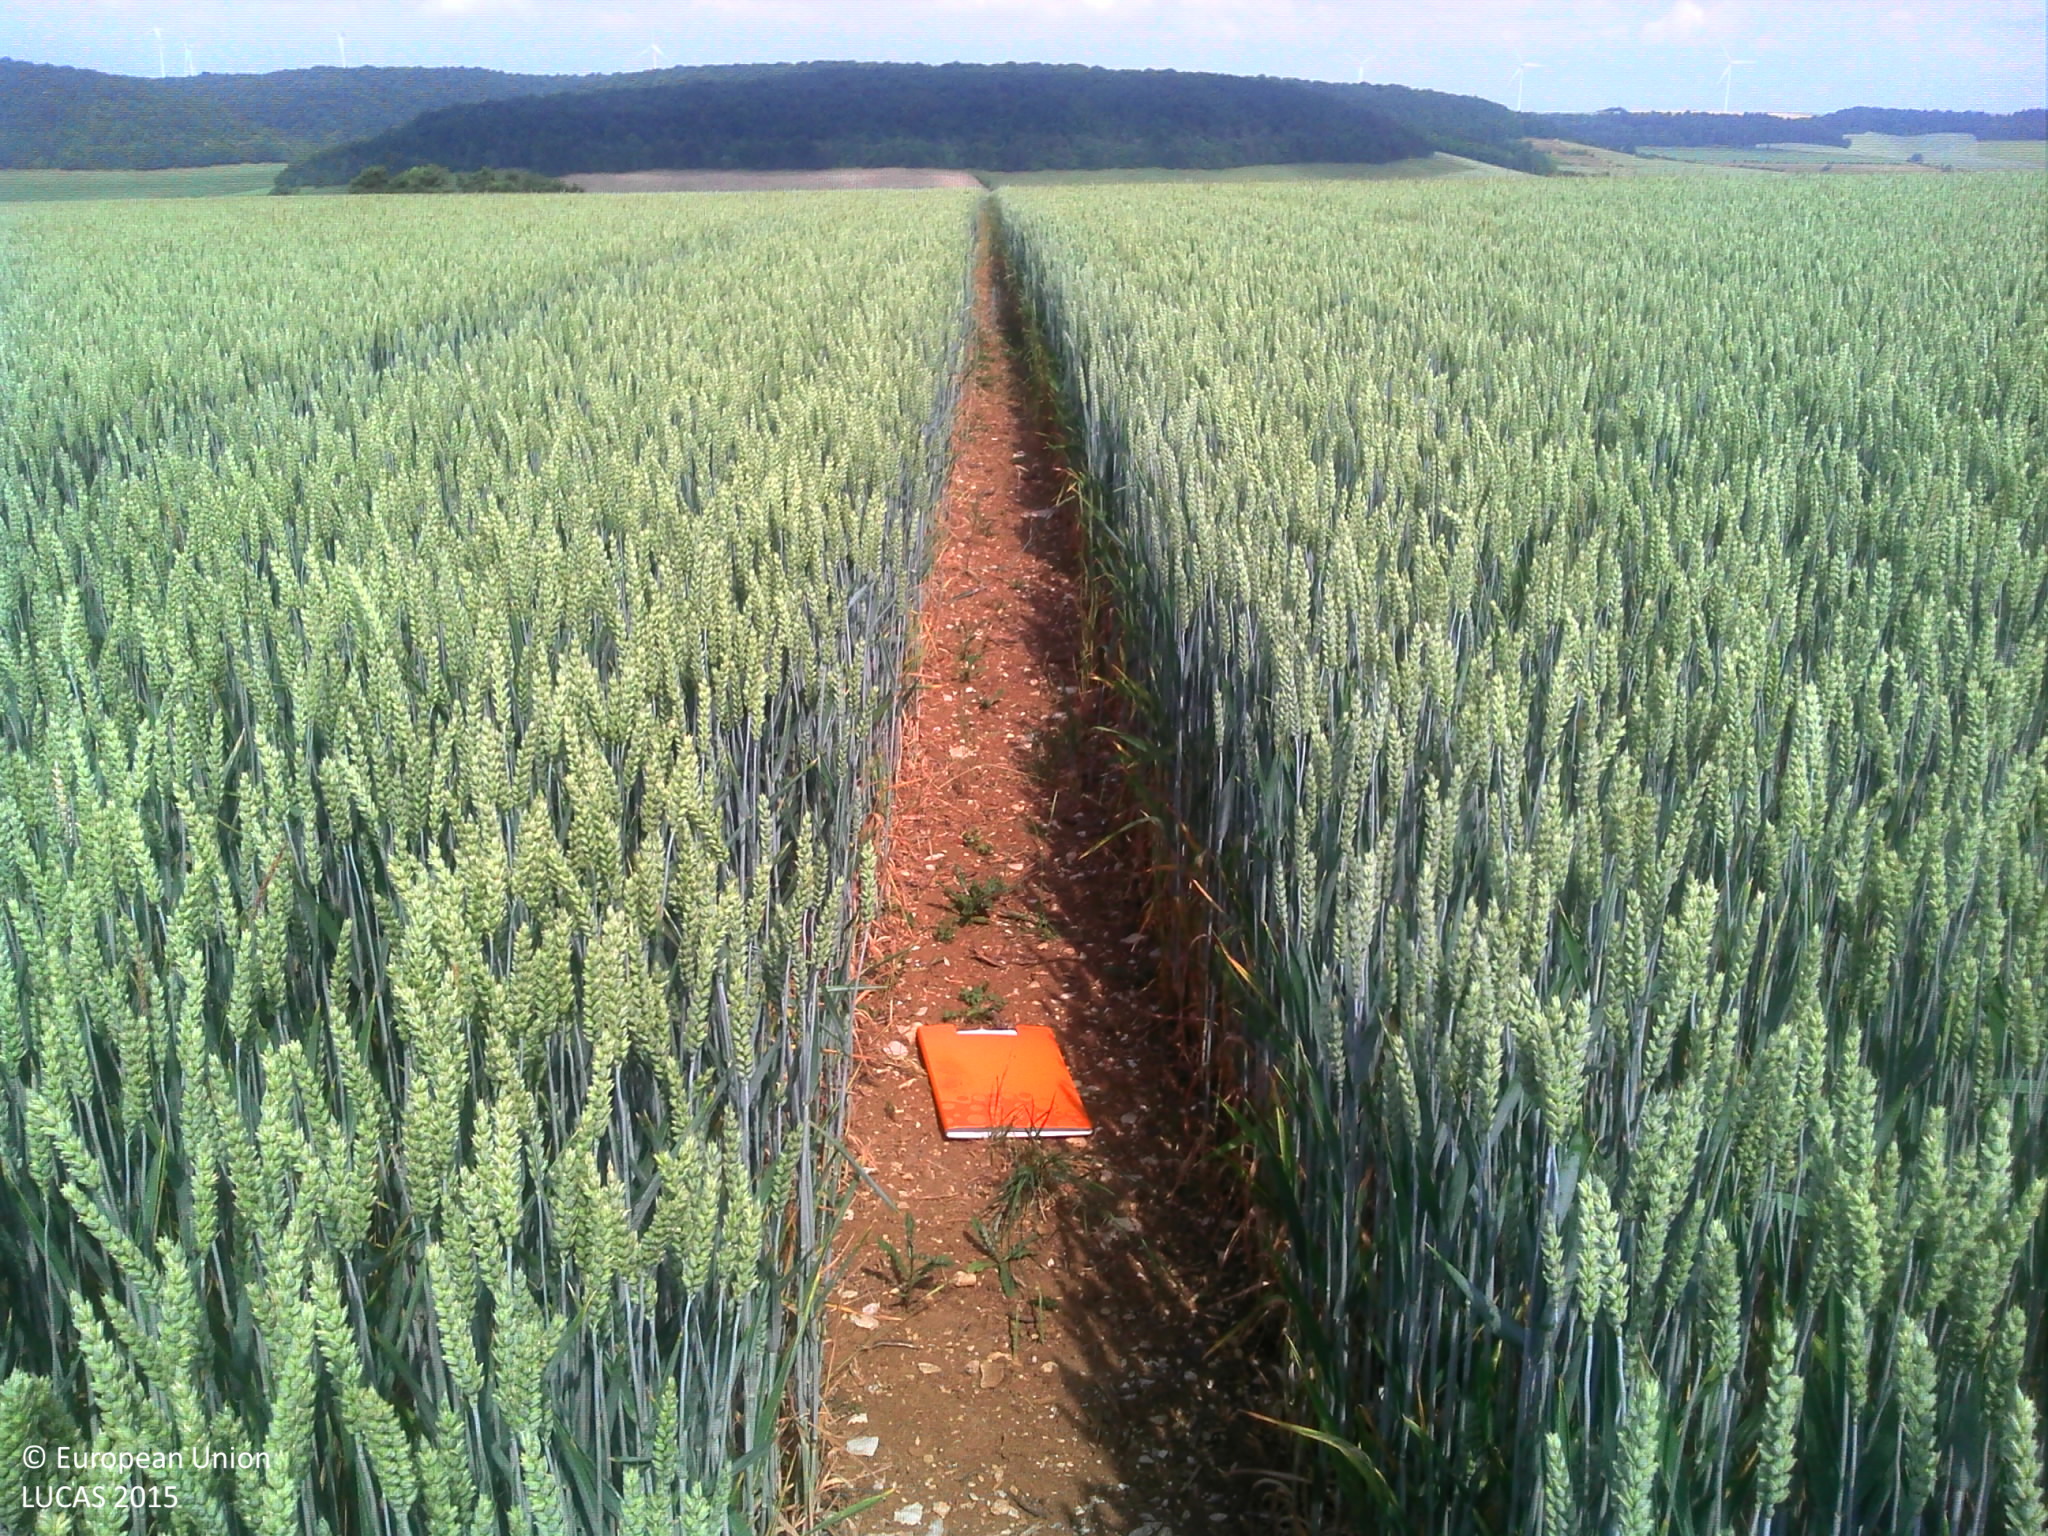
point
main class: Cropland
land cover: Common wheat
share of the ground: > 75 %
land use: Agriculture (excluding fallow land and kitchen gardens)
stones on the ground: 10 - 25 %
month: June
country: FR
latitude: 48.3058
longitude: 4.9427
